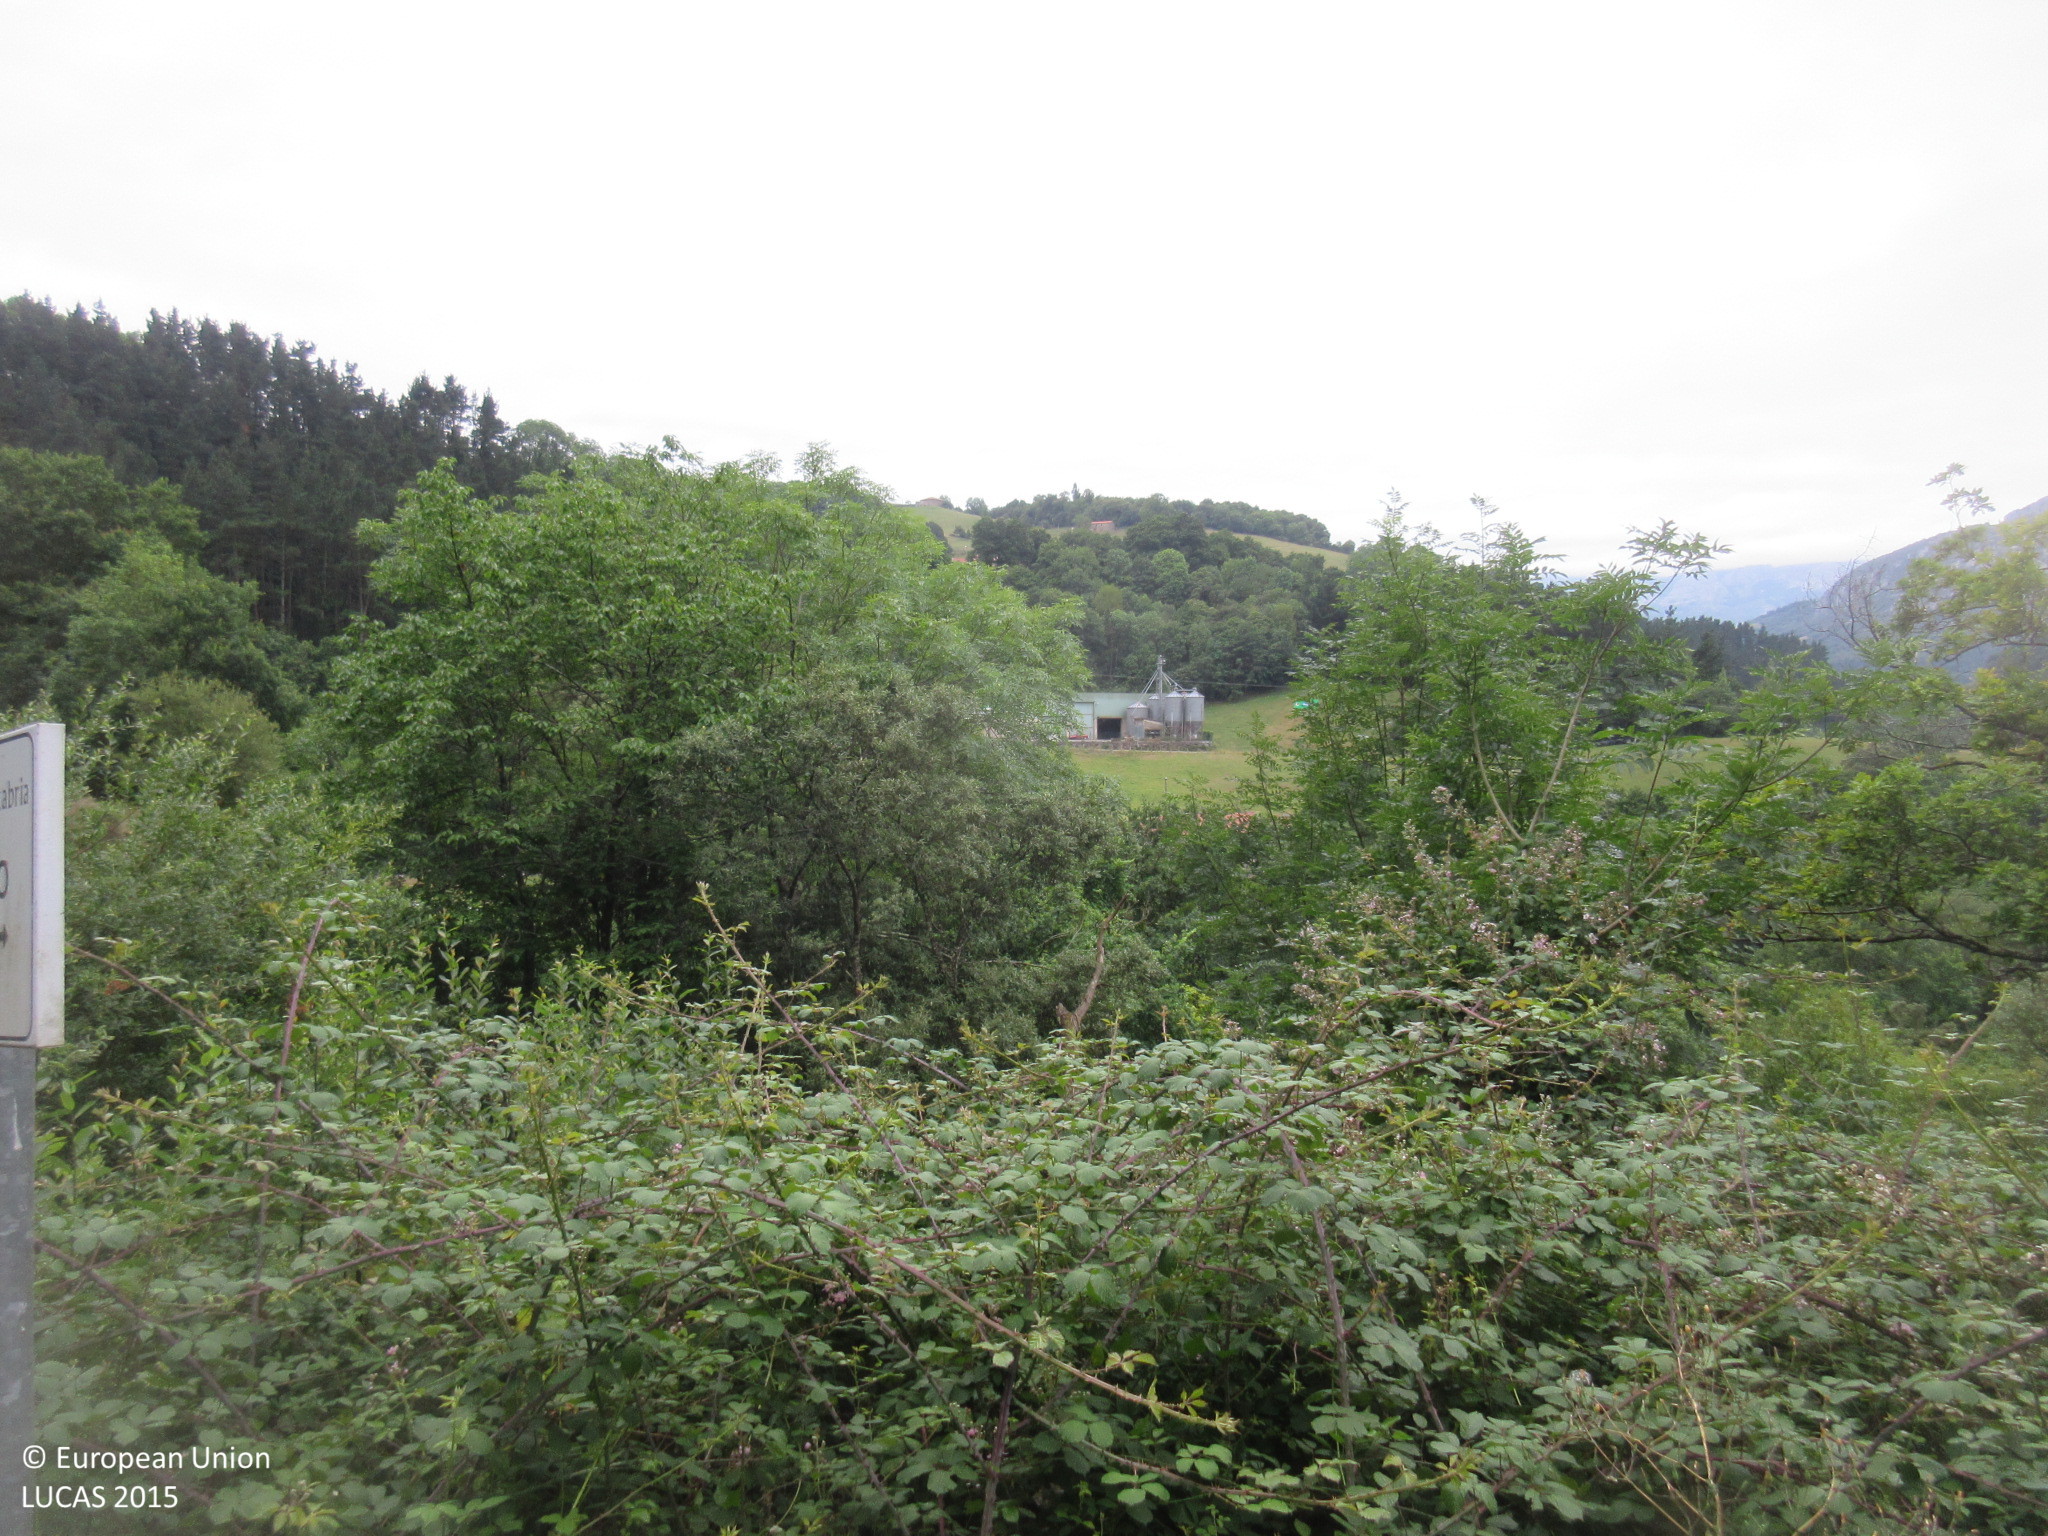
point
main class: Woodland
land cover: Broadleaved woodland
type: acidophilous oak and oak-birch forest
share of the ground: > 75 %
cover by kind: broadleaved forest trees 90 %, shrubs 10 %
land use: Semi-natural and natural areas not in use
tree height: > 5 m
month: July
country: ES
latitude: 43.2118
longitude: -3.4707
